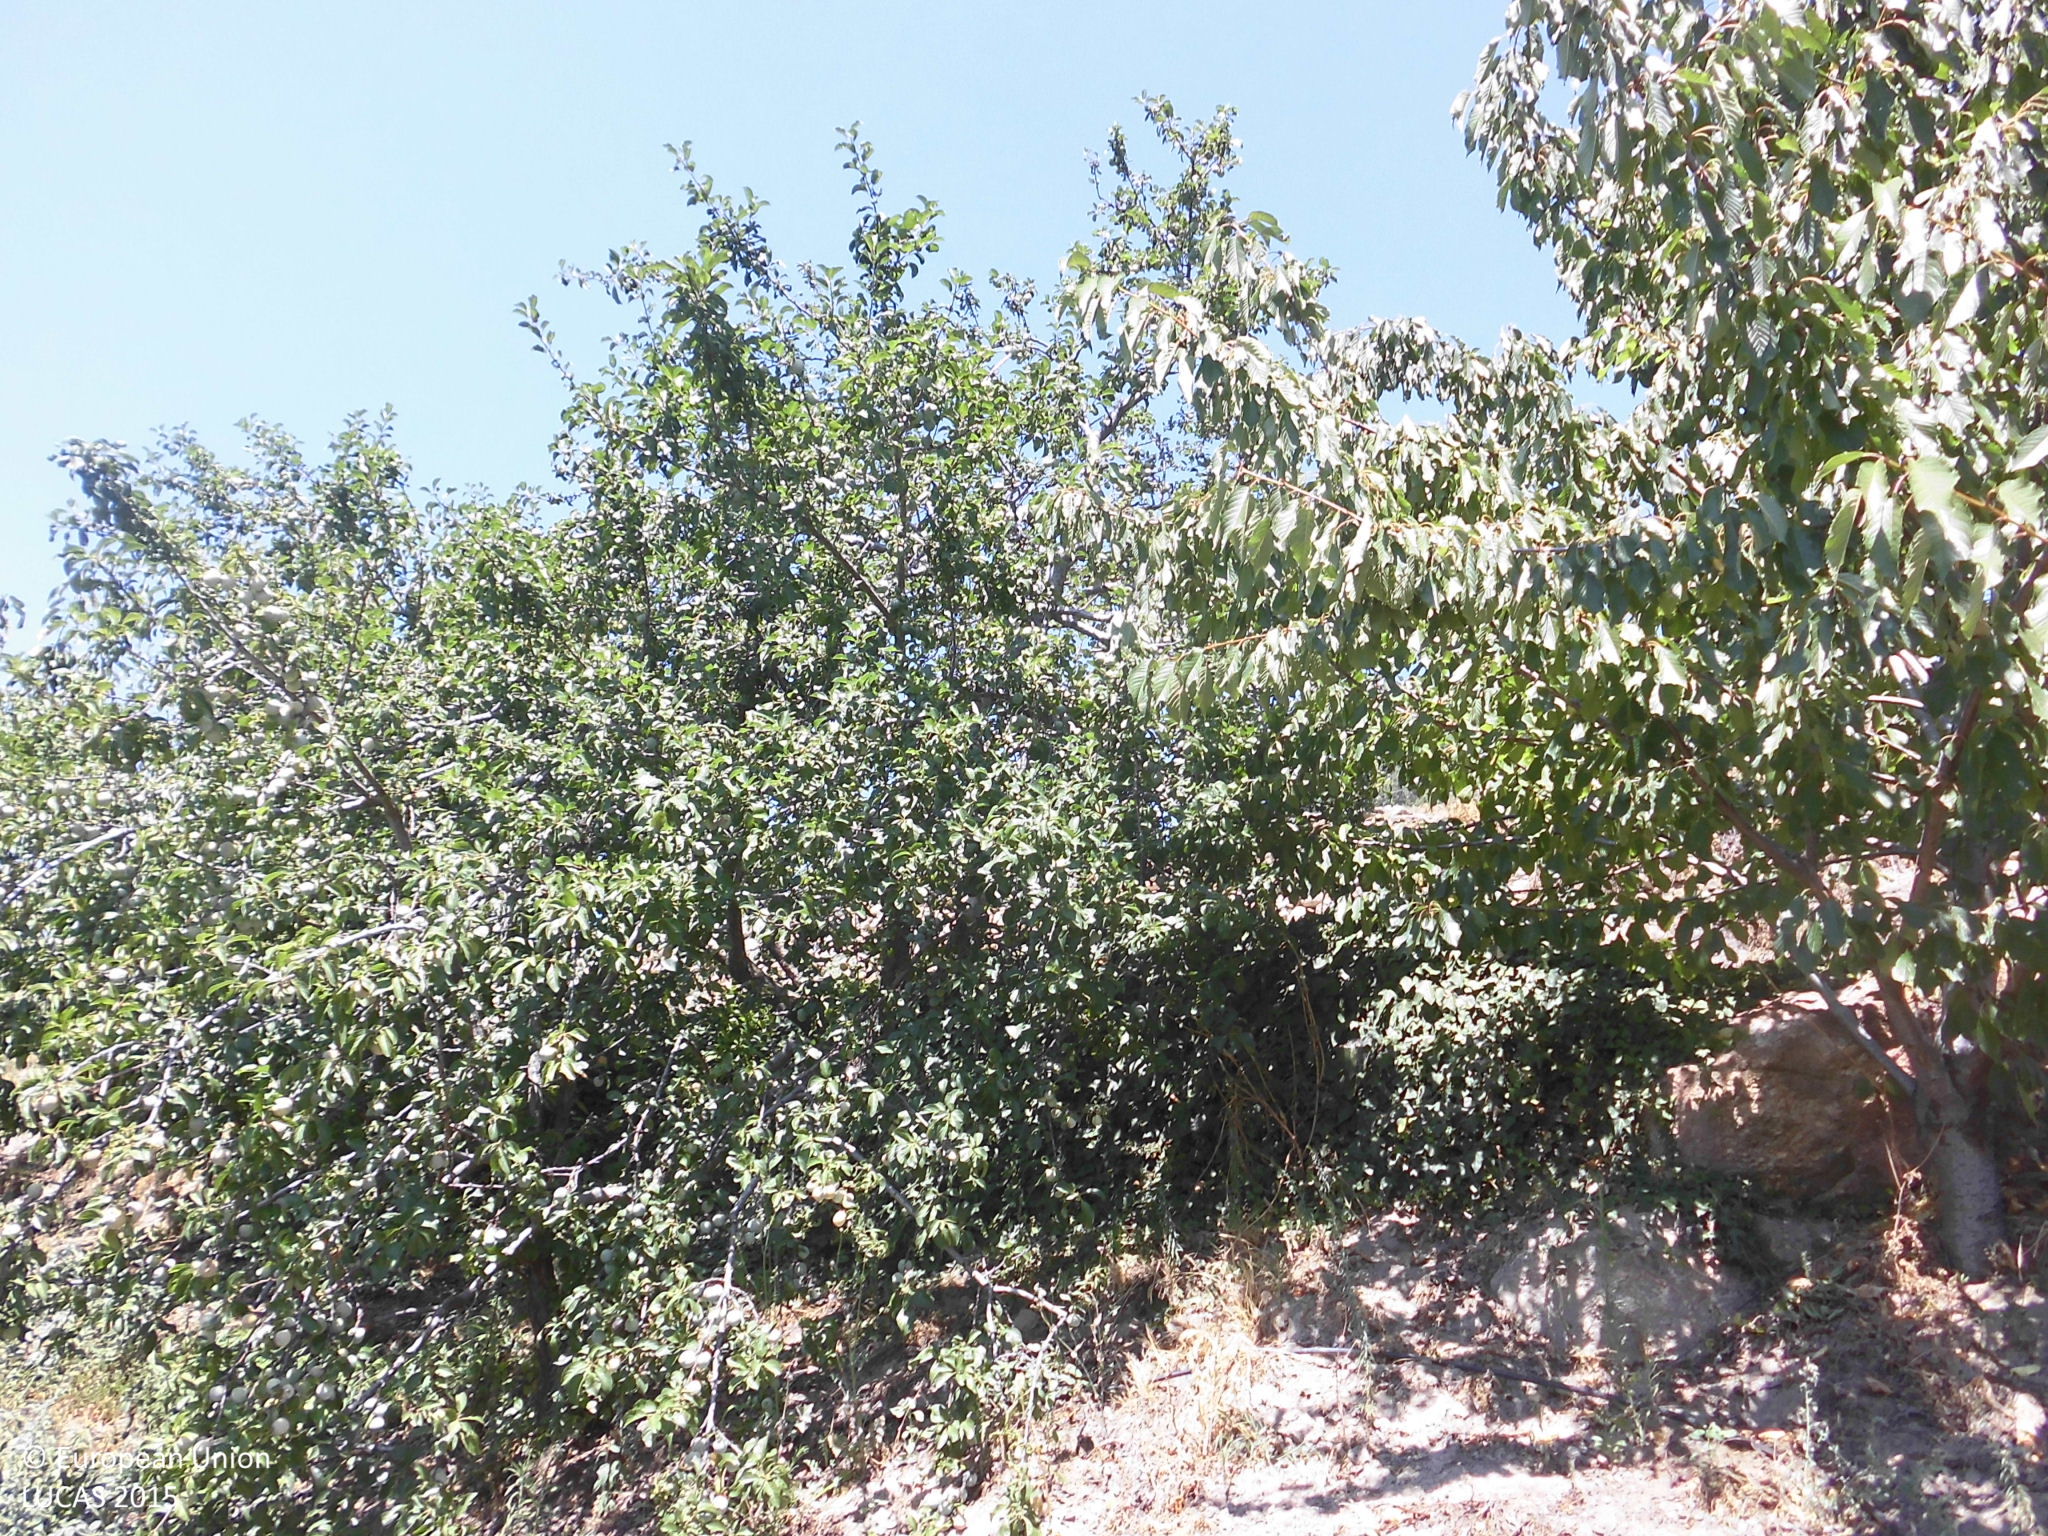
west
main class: Cropland
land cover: Cherry fruit
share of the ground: 25 - 50 %
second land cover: Grassland without tree/shrub cover
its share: > 75 %
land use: Agriculture (excluding fallow land and kitchen gardens)
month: July
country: ES
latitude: 40.1307
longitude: -5.9486
